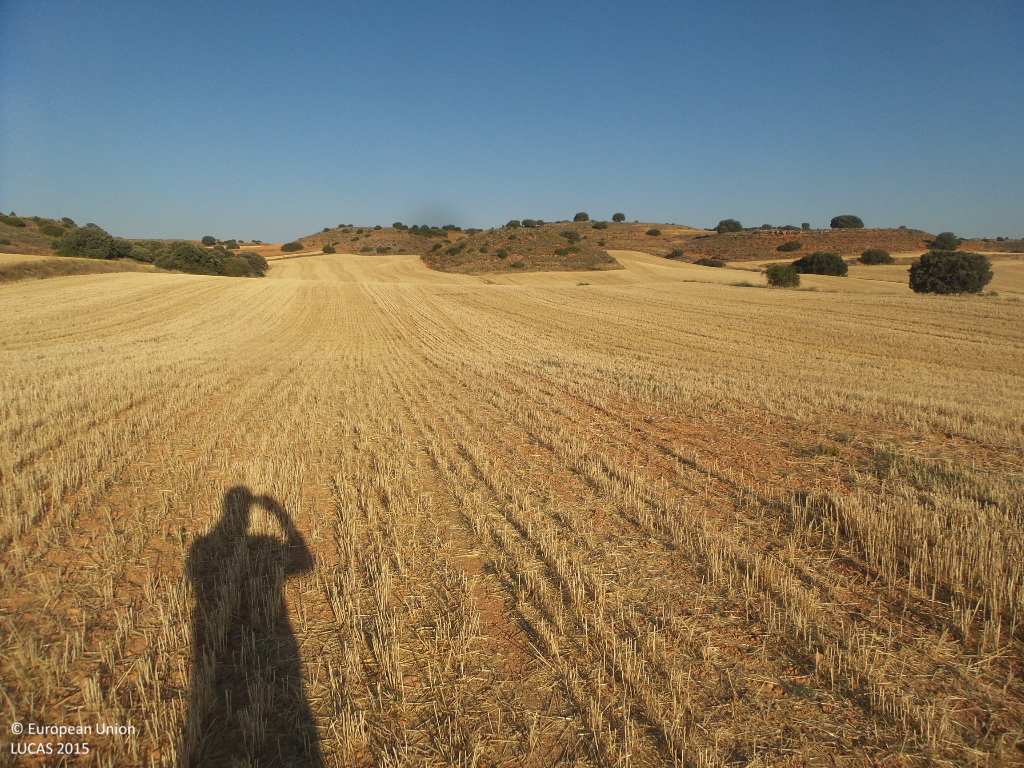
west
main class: Cropland
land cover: Barley
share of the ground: < 10 %
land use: Agriculture (excluding fallow land and kitchen gardens)
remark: Harvested field
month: July
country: ES
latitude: 41.2721
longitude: -2.0737
